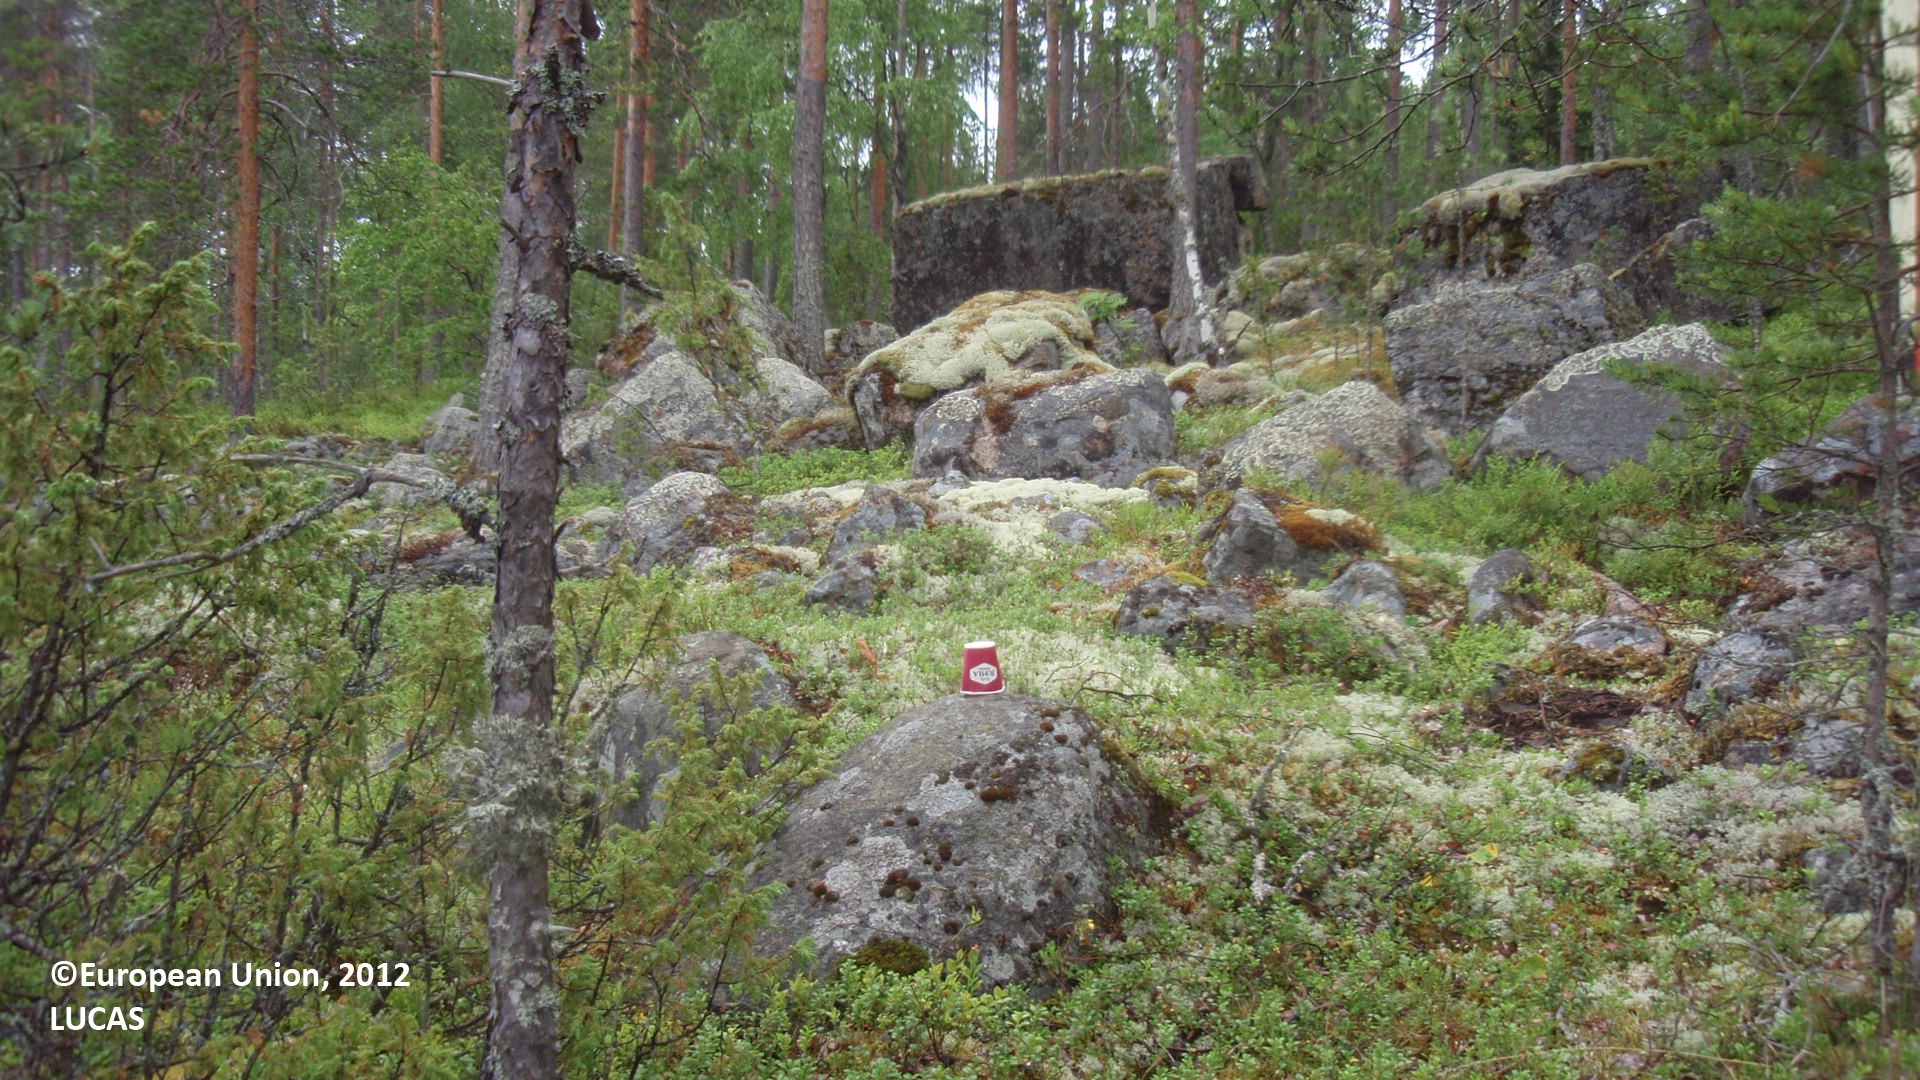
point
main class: Woodland
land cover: Pine dominated coniferous woodland
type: boreal forest
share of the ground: 25 - 50 %
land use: Forestry
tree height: > 5 m
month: July
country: FI
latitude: 61.5066
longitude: 28.3391
